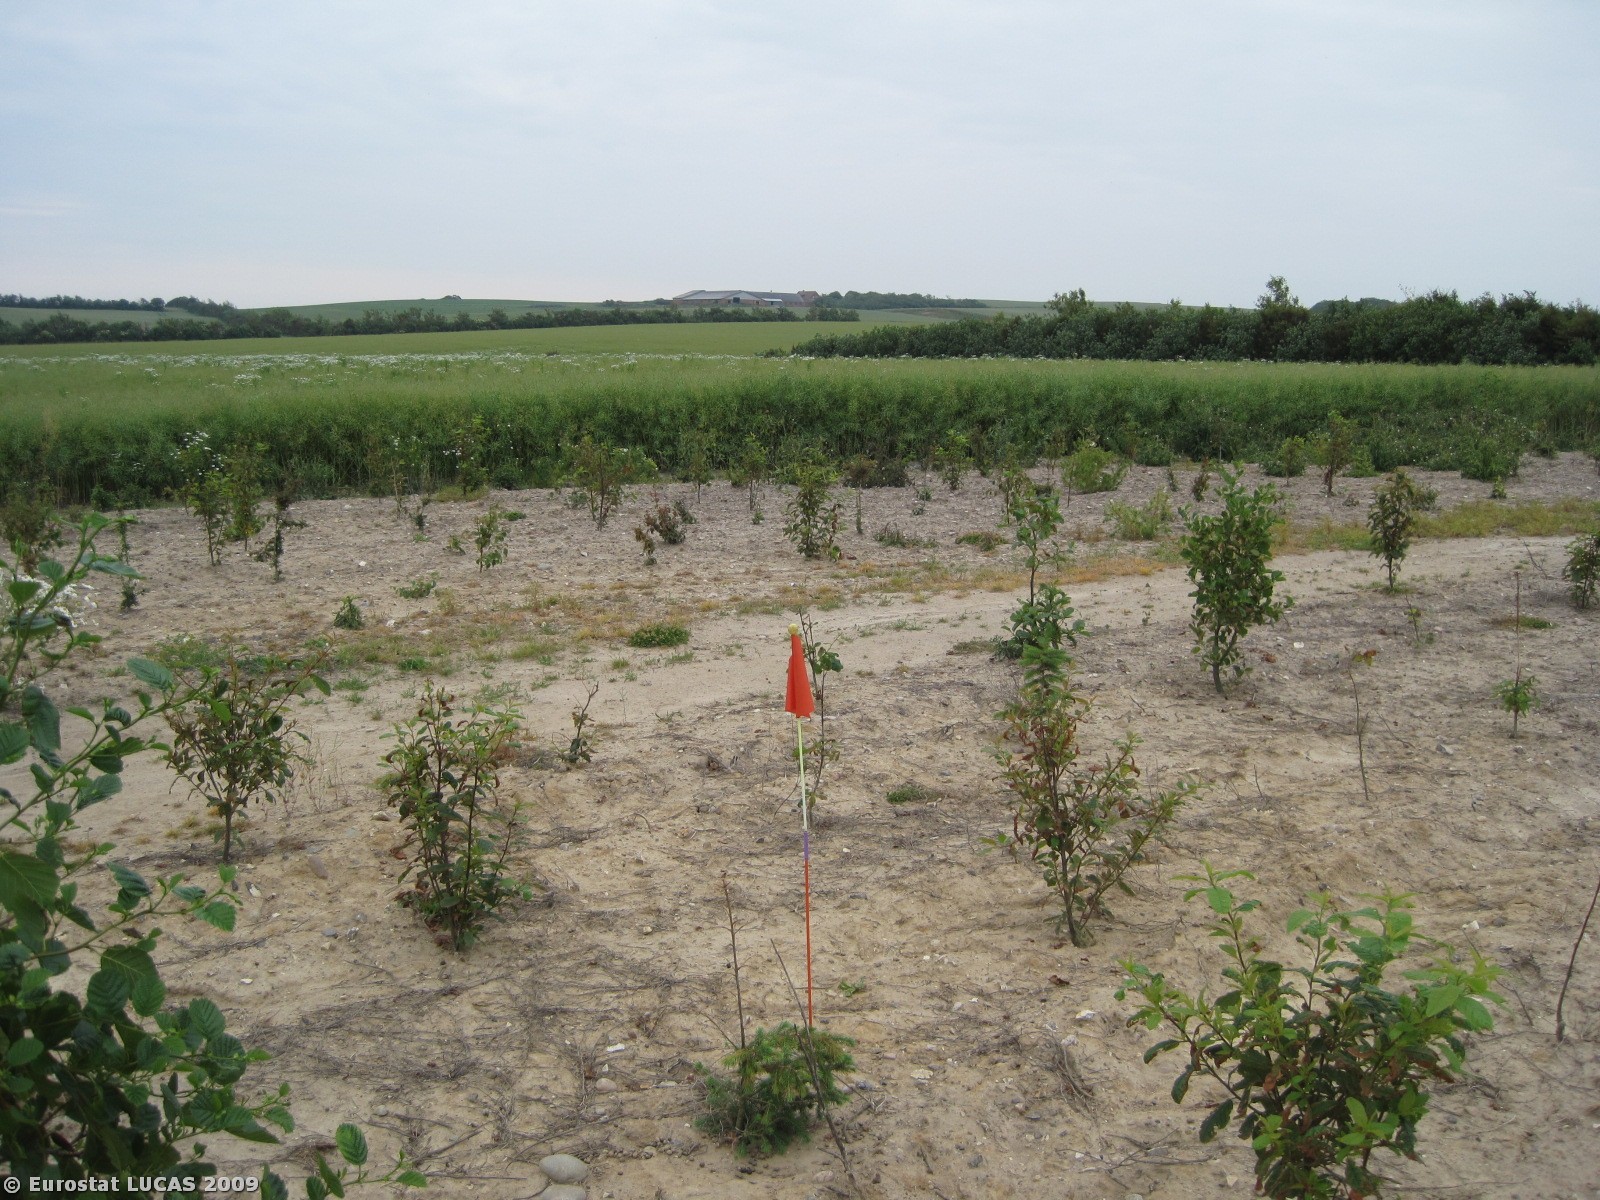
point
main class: Grassland
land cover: Grassland with sparse tree/shrub cover
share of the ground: 10 - 25 %
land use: Agriculture (excluding fallow land and kitchen gardens)
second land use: Amenities, museums, leisure
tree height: < 5 m
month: June
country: DK
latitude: 56.5724
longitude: 8.3256
